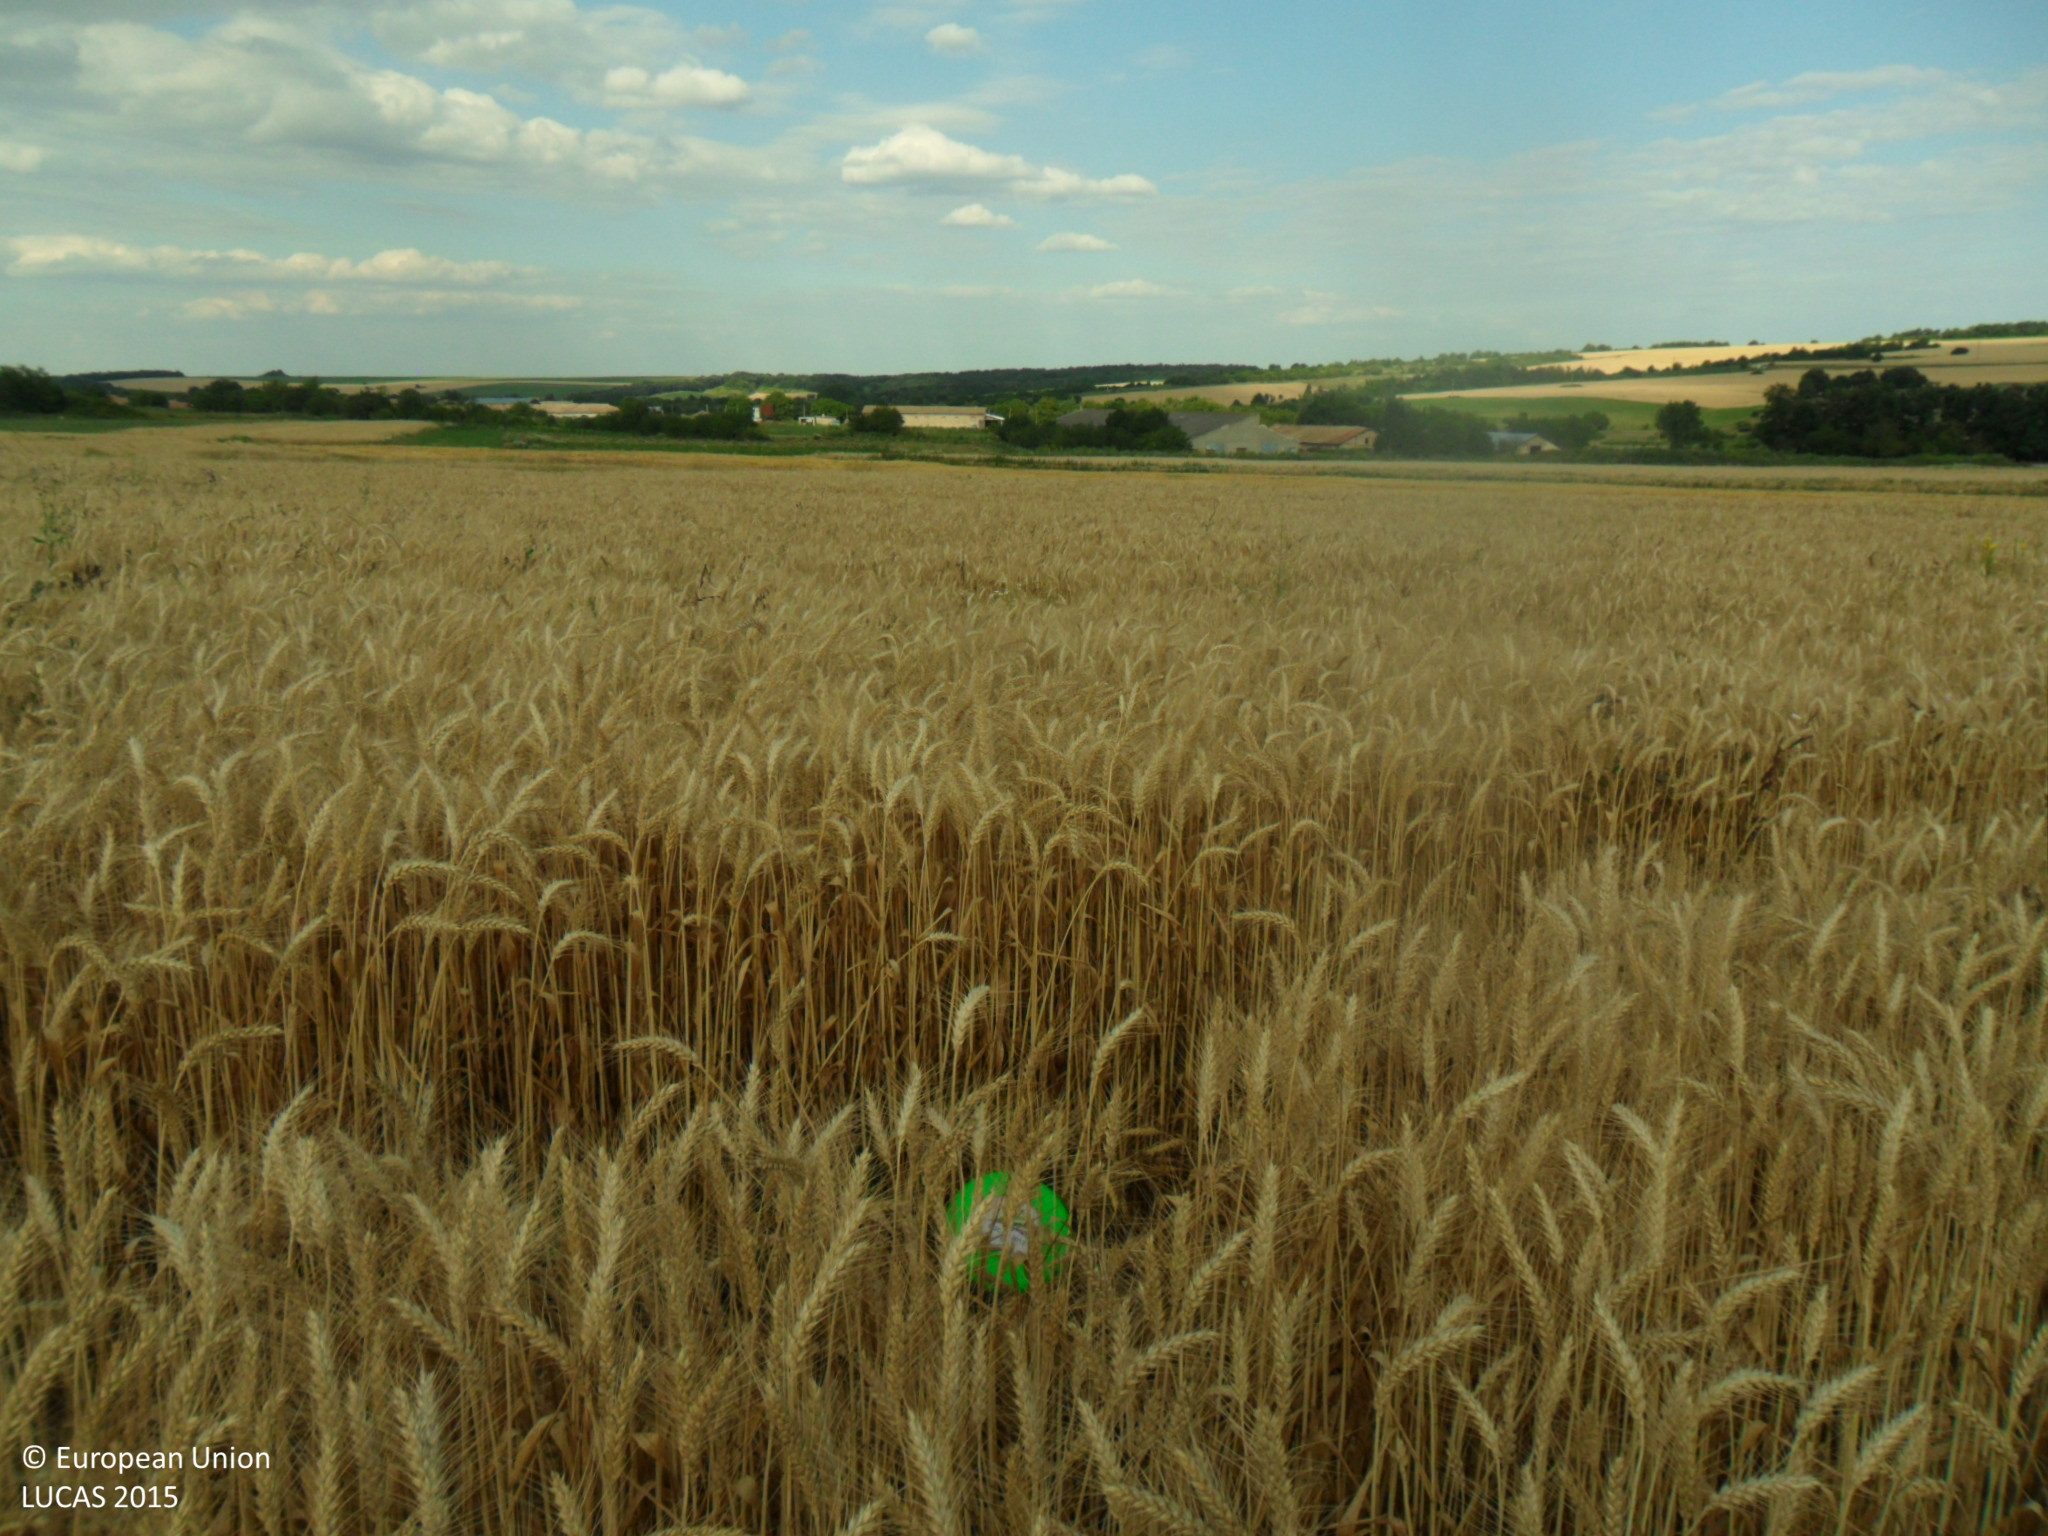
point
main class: Cropland
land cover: Common wheat
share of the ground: > 75 %
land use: Agriculture (excluding fallow land and kitchen gardens)
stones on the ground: < 10 %
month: June
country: BG
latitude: 43.5305
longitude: 27.2879
